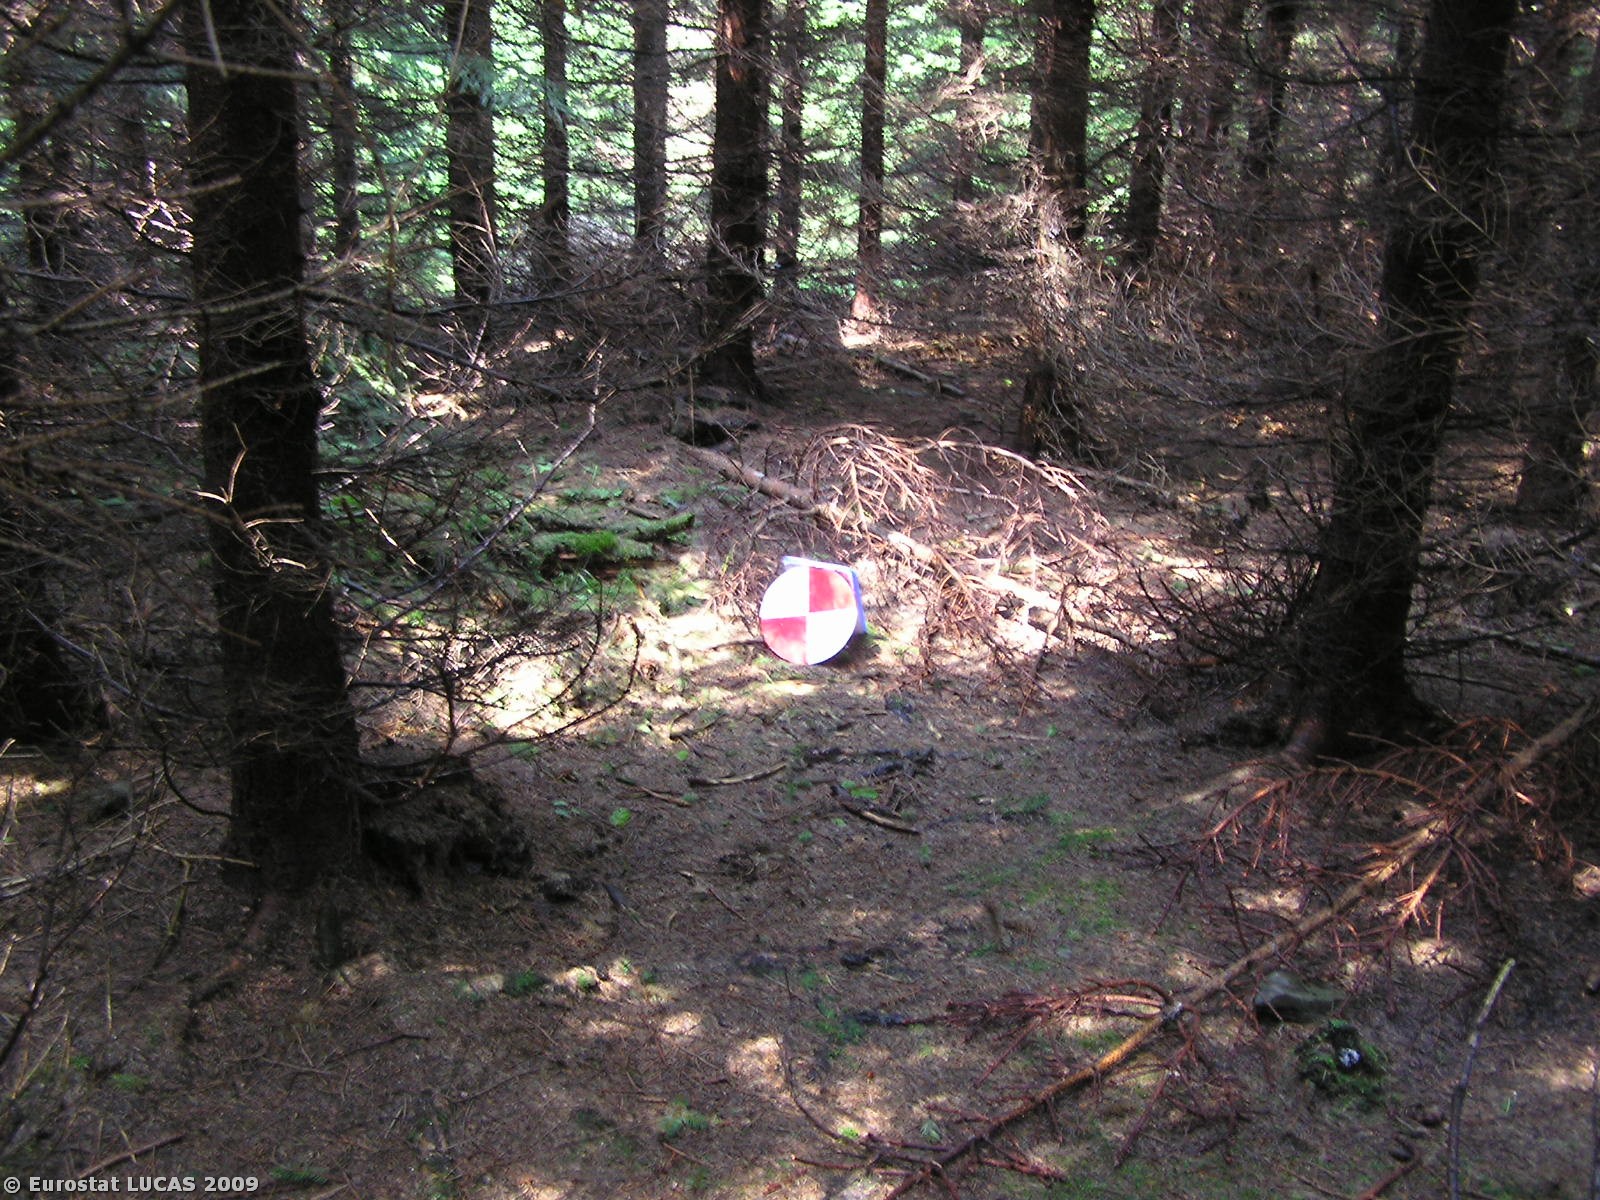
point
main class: Woodland
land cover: Coniferous woodland
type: hemiboreal forest and nemoral coniferous forest and mixed broadleaved-coniferous forest
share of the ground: > 75 %
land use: Forestry
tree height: > 5 m
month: June
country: CZ
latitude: 50.2110
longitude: 17.4530
